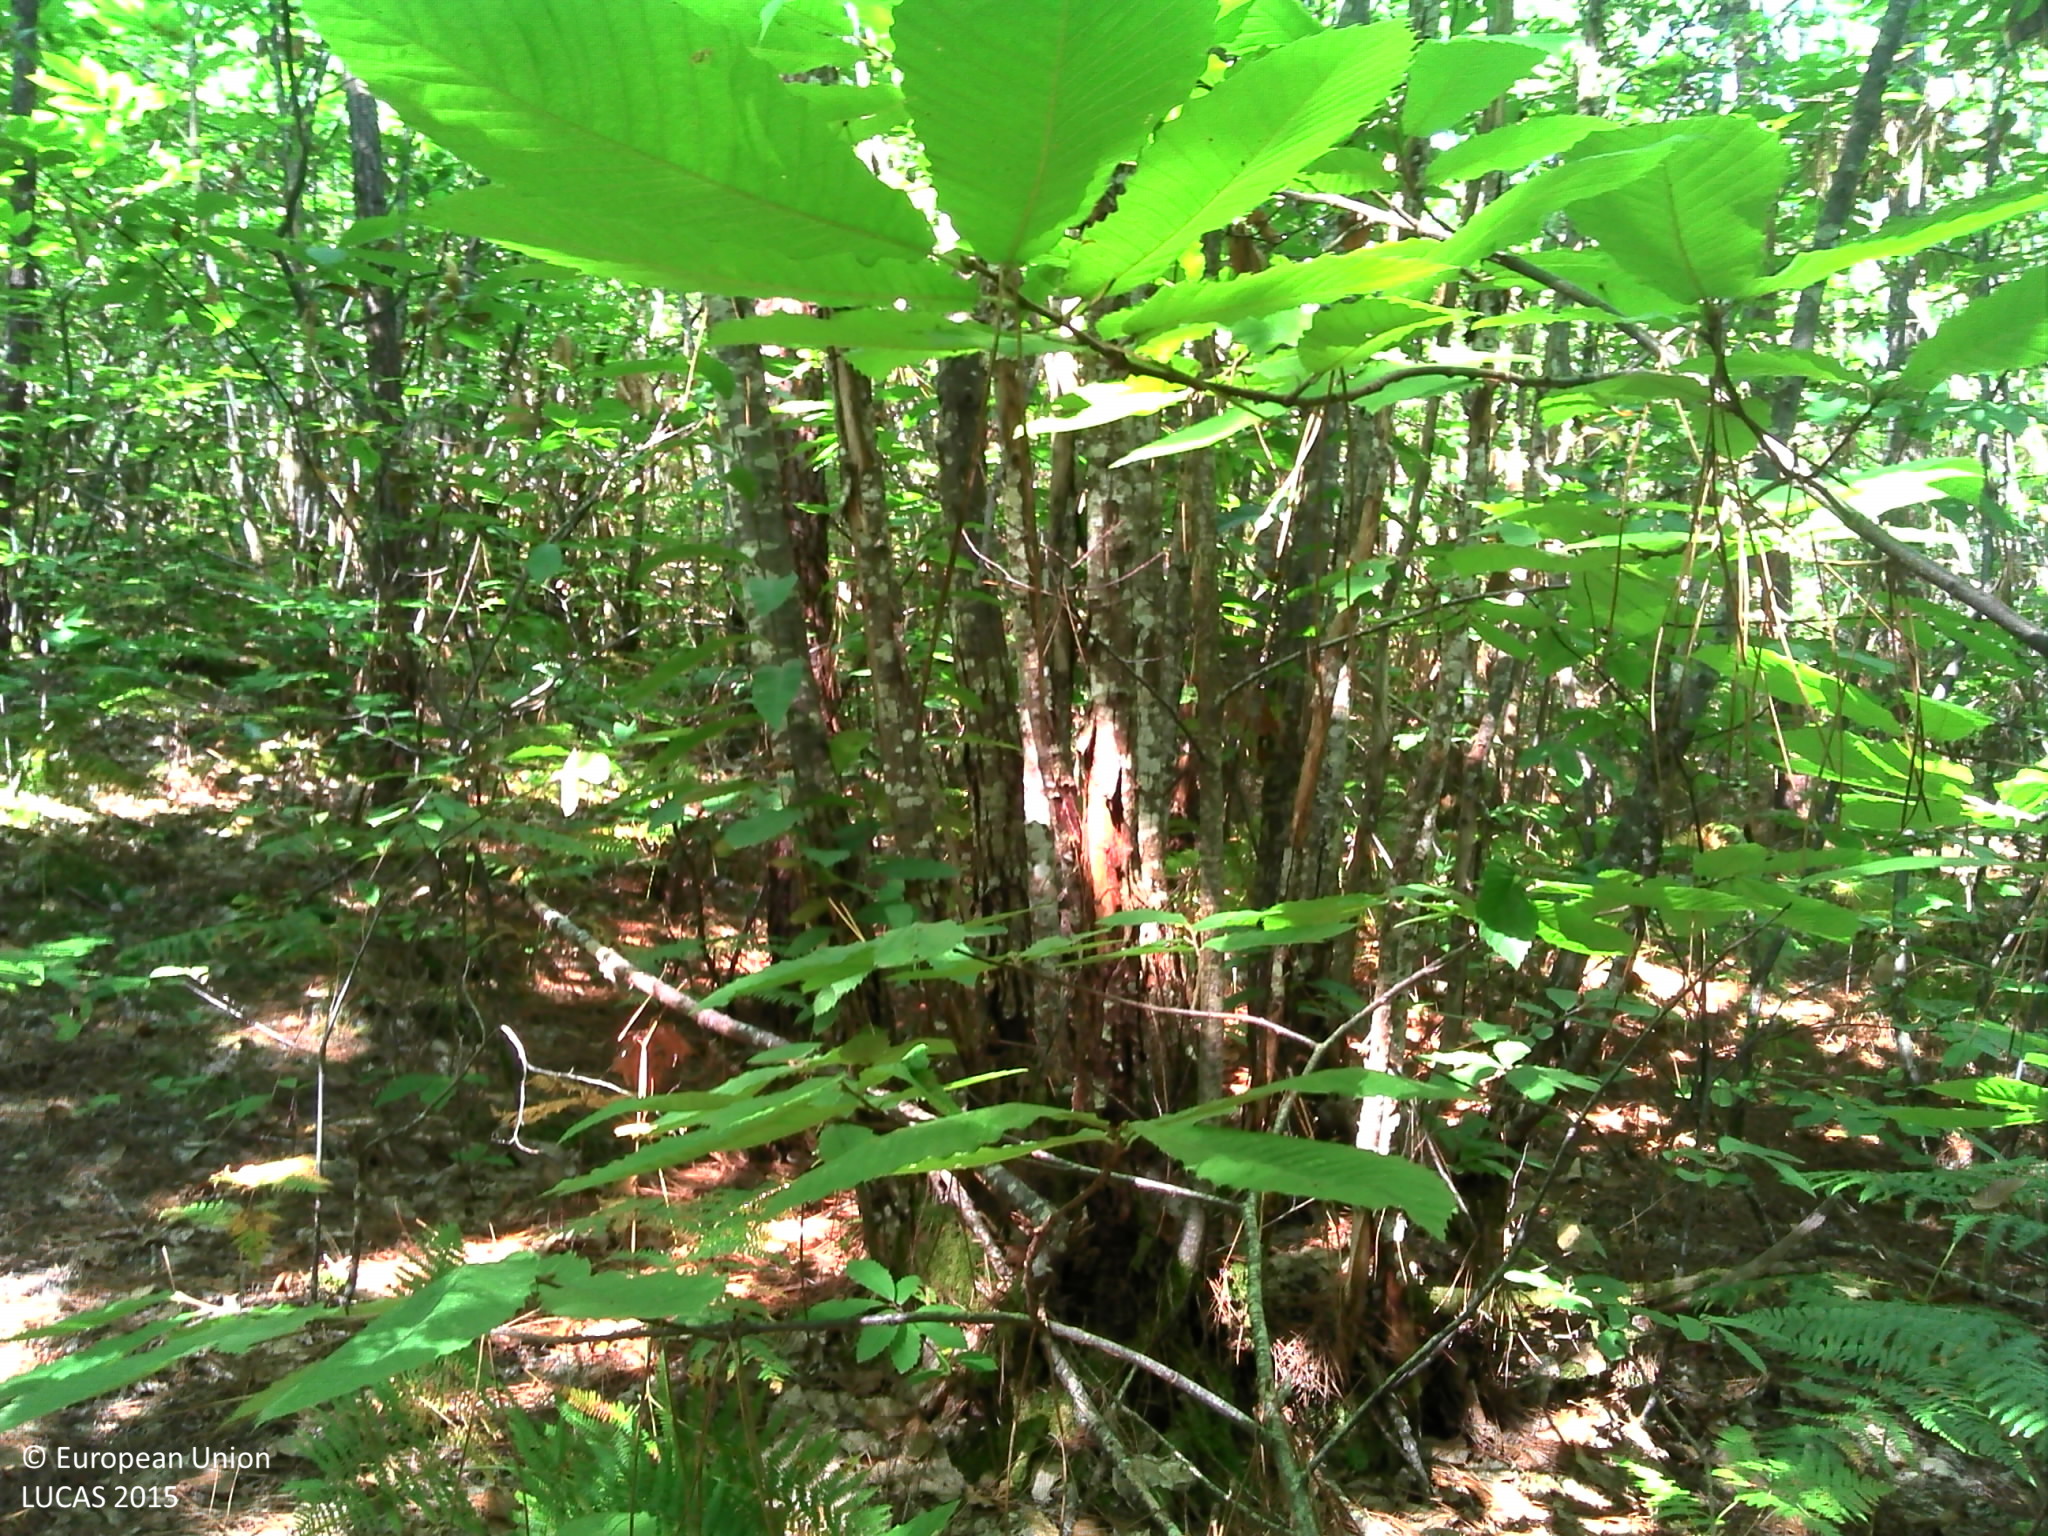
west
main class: Woodland
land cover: Pine dominated mixed woodland
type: thermophilous deciduous forest
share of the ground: > 75 %
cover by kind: broadleaved forest trees 40 %, coniferous forest trees 30 %, herbaceous plants 20 %, shrubs 5 %, consolidated bare surface 5 %
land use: Forestry
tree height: > 5 m
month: August
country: FR
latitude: 45.1420
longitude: 0.4376
